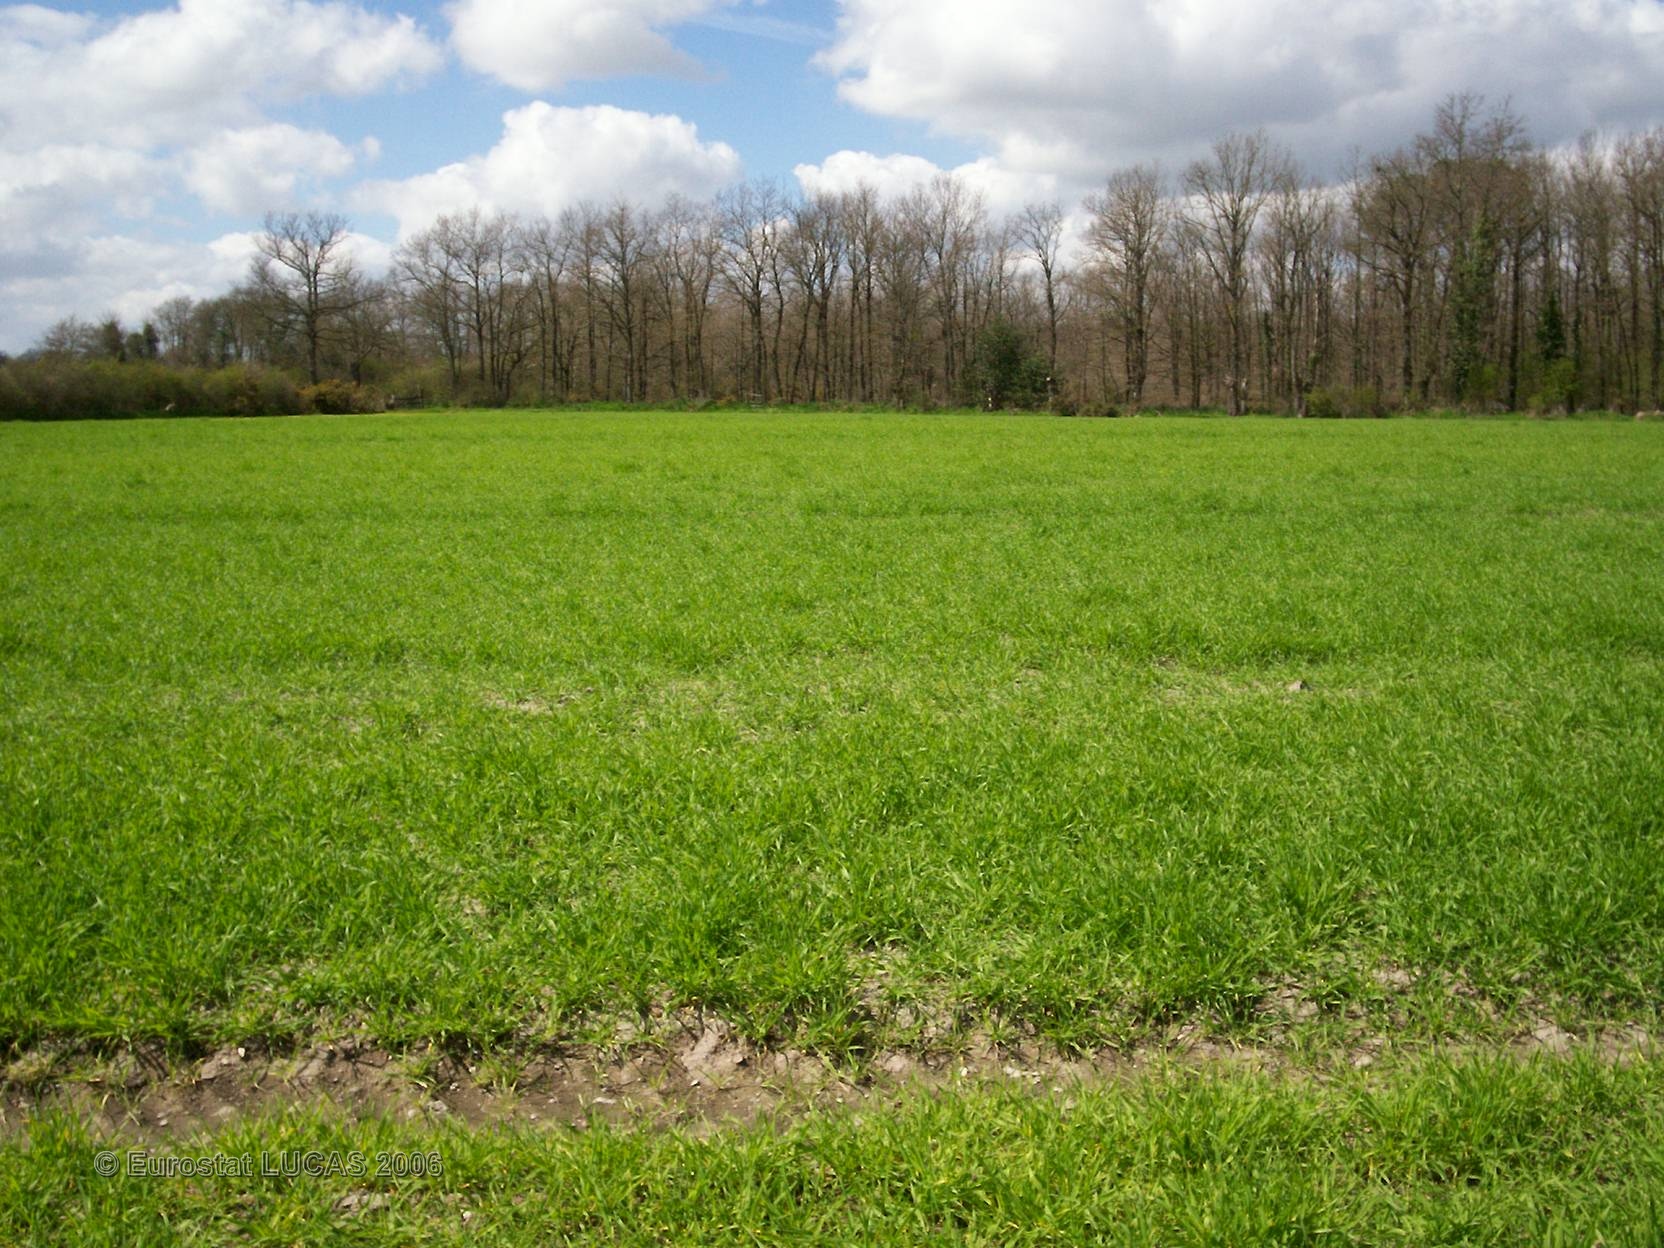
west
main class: Cropland
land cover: Barley
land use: Agriculture (excluding fallow land and kitchen gardens)
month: April
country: FR
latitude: 46.7776
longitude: -0.3070
